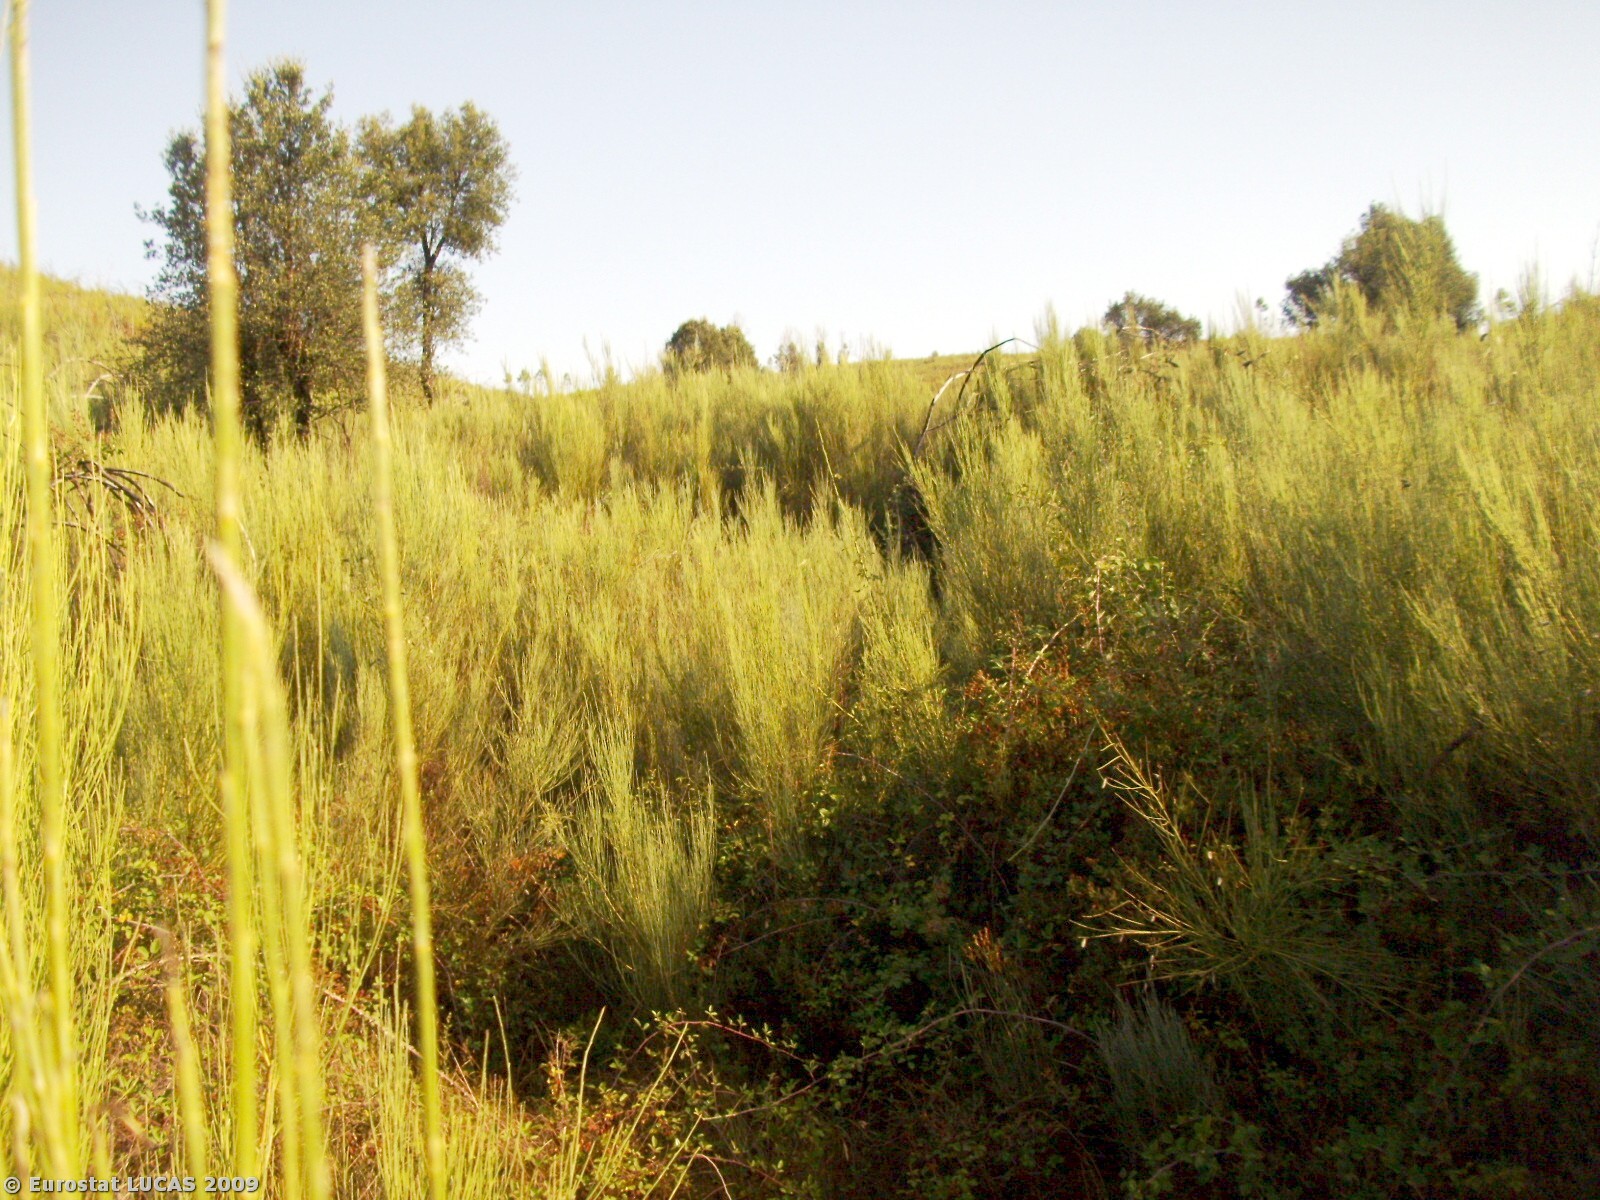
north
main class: Shrubland
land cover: Shrubland with sparse tree cover
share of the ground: > 75 %
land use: Forestry
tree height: > 5 m
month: August
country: PT
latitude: 40.1603
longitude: -7.6857
